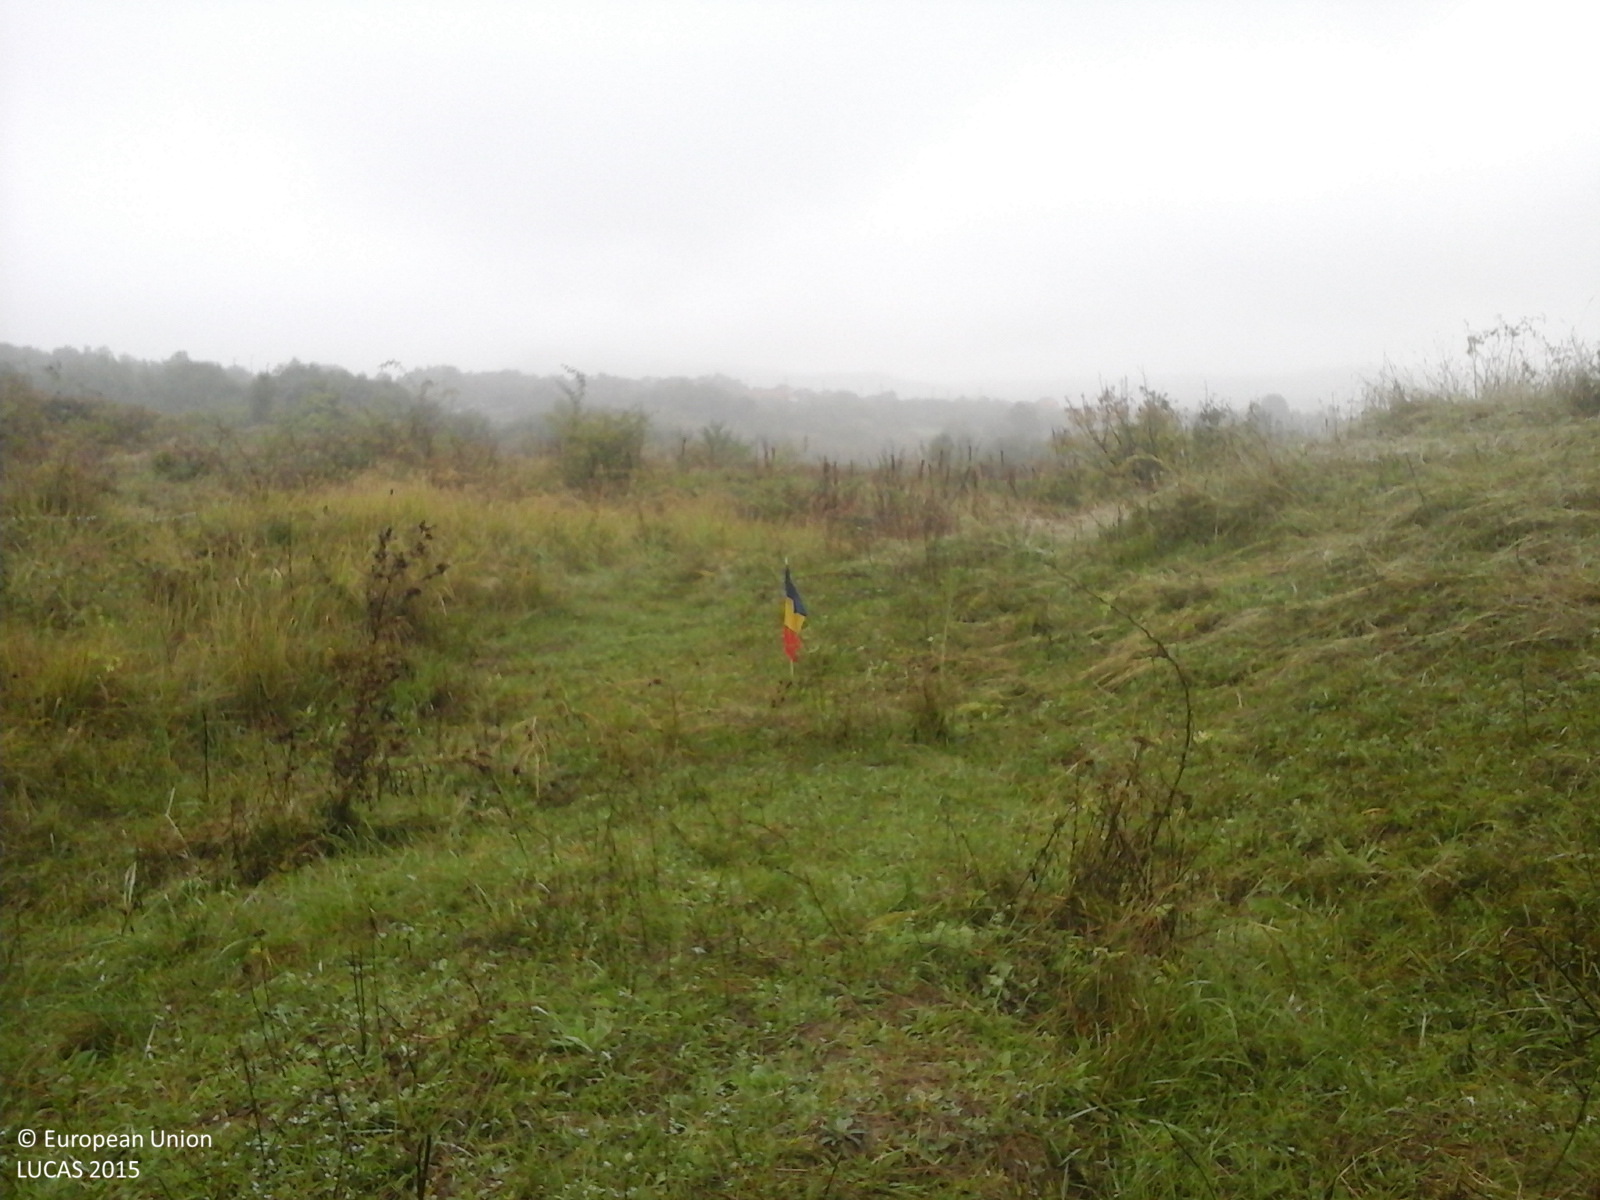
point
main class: Grassland
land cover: Grassland with sparse tree/shrub cover
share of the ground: > 75 %
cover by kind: herbaceous plants 85 %, shrubs 10 %, broadleaved forest trees 5 %
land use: Agriculture (excluding fallow land and kitchen gardens)
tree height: < 5 m
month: September
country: RO
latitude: 44.9937
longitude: 23.6706
